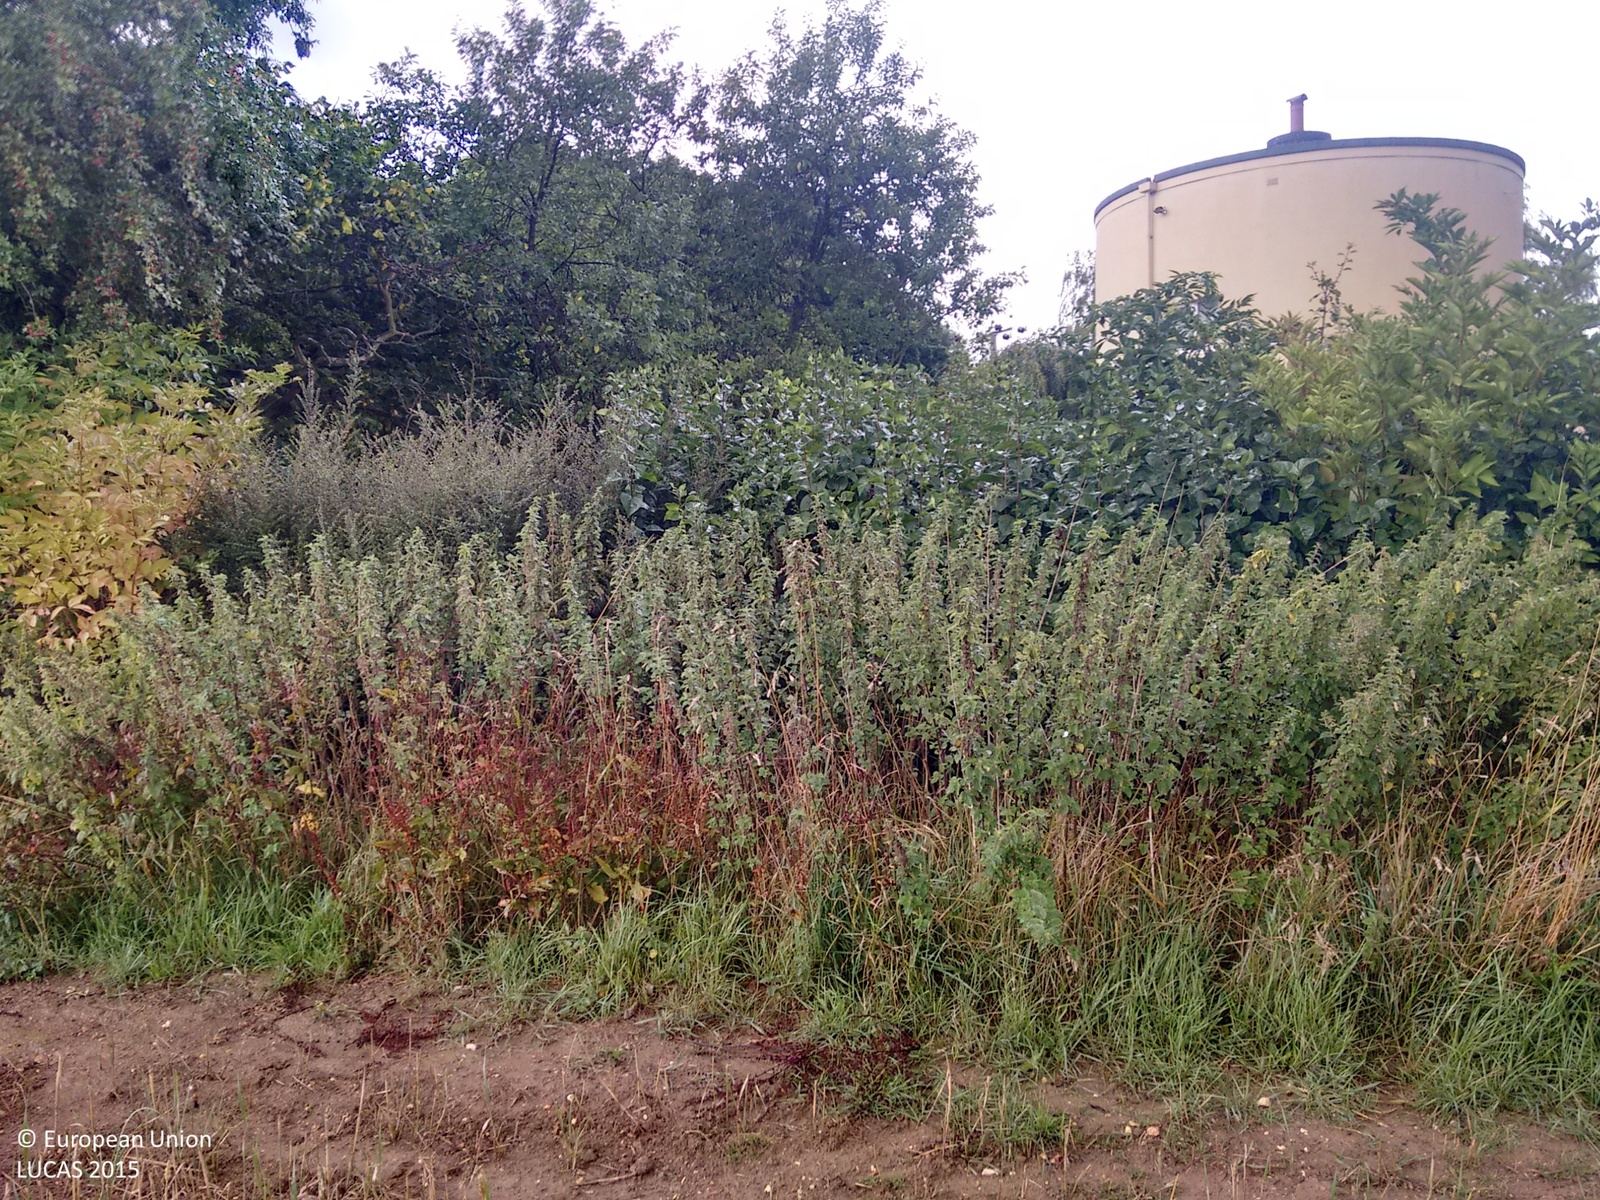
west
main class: Cropland
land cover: Common wheat
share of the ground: > 75 %
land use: Agriculture (excluding fallow land and kitchen gardens)
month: August
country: GB
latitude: 52.1884
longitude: 0.4198
